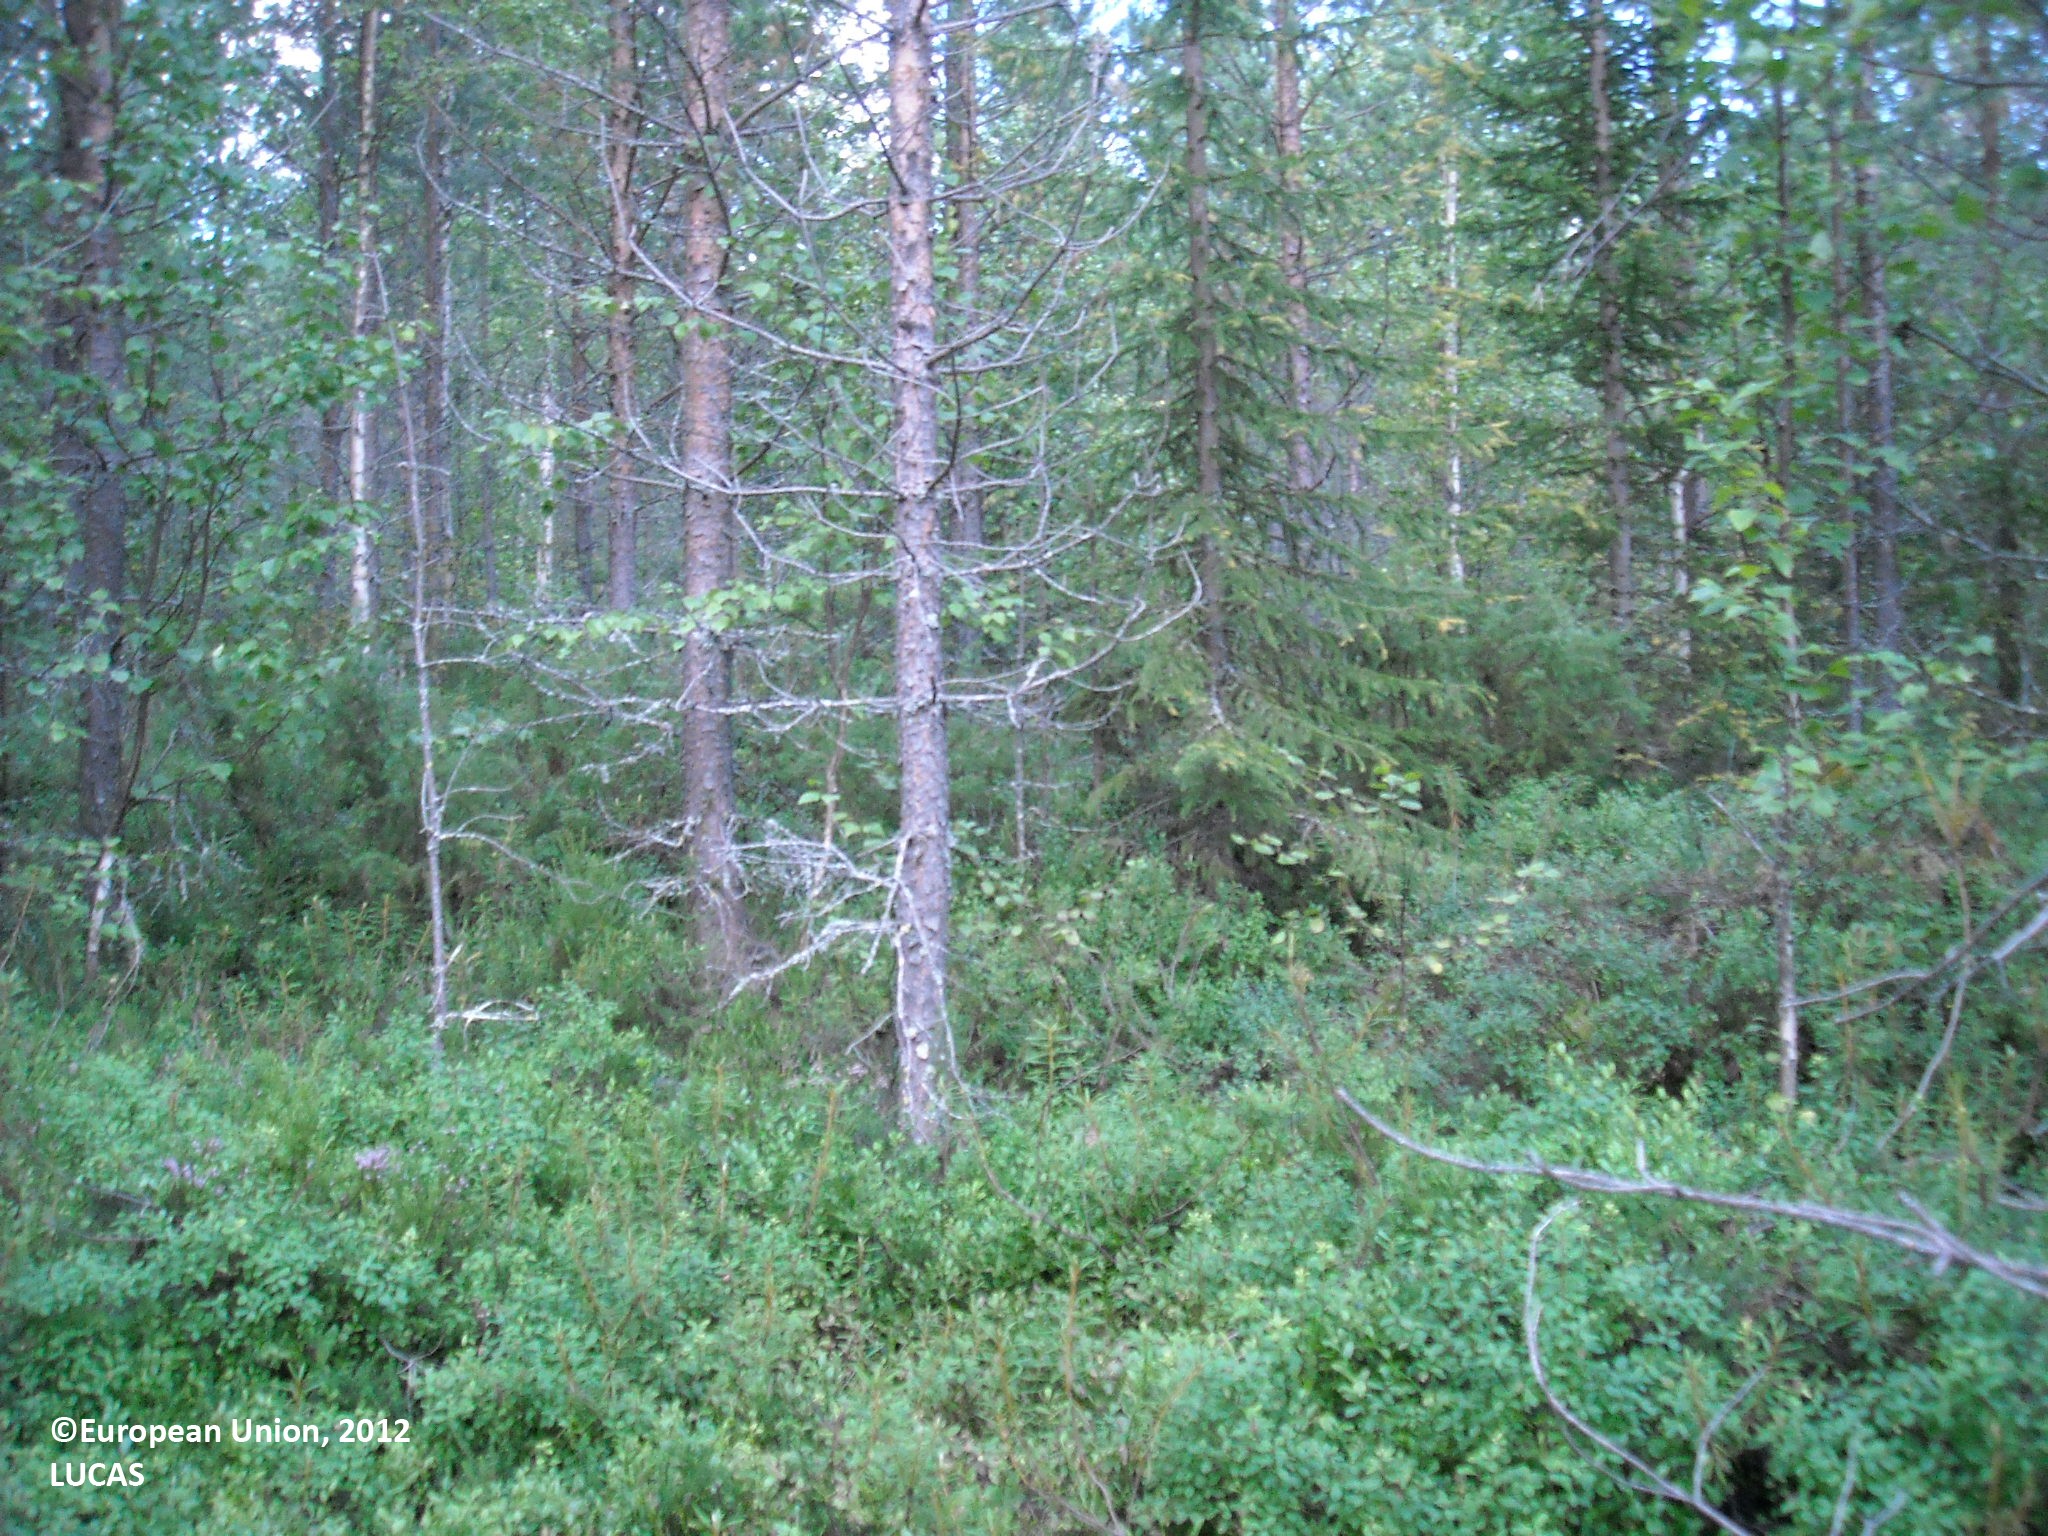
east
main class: Woodland
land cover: Other mixed woodland
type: boreal forest
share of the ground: > 75 %
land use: Forestry
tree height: > 5 m
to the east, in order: Other mixed woodland; Pine dominated mixed woodland; Other mixed woodland; Ditches and canals; Grass margins; Paved roads, cycling and walking lanes; Grass margins; Ditches and canals; Abandoned hedges; Pine dominated mixed woodland
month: August
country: FI
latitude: 65.1822
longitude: 27.6691
